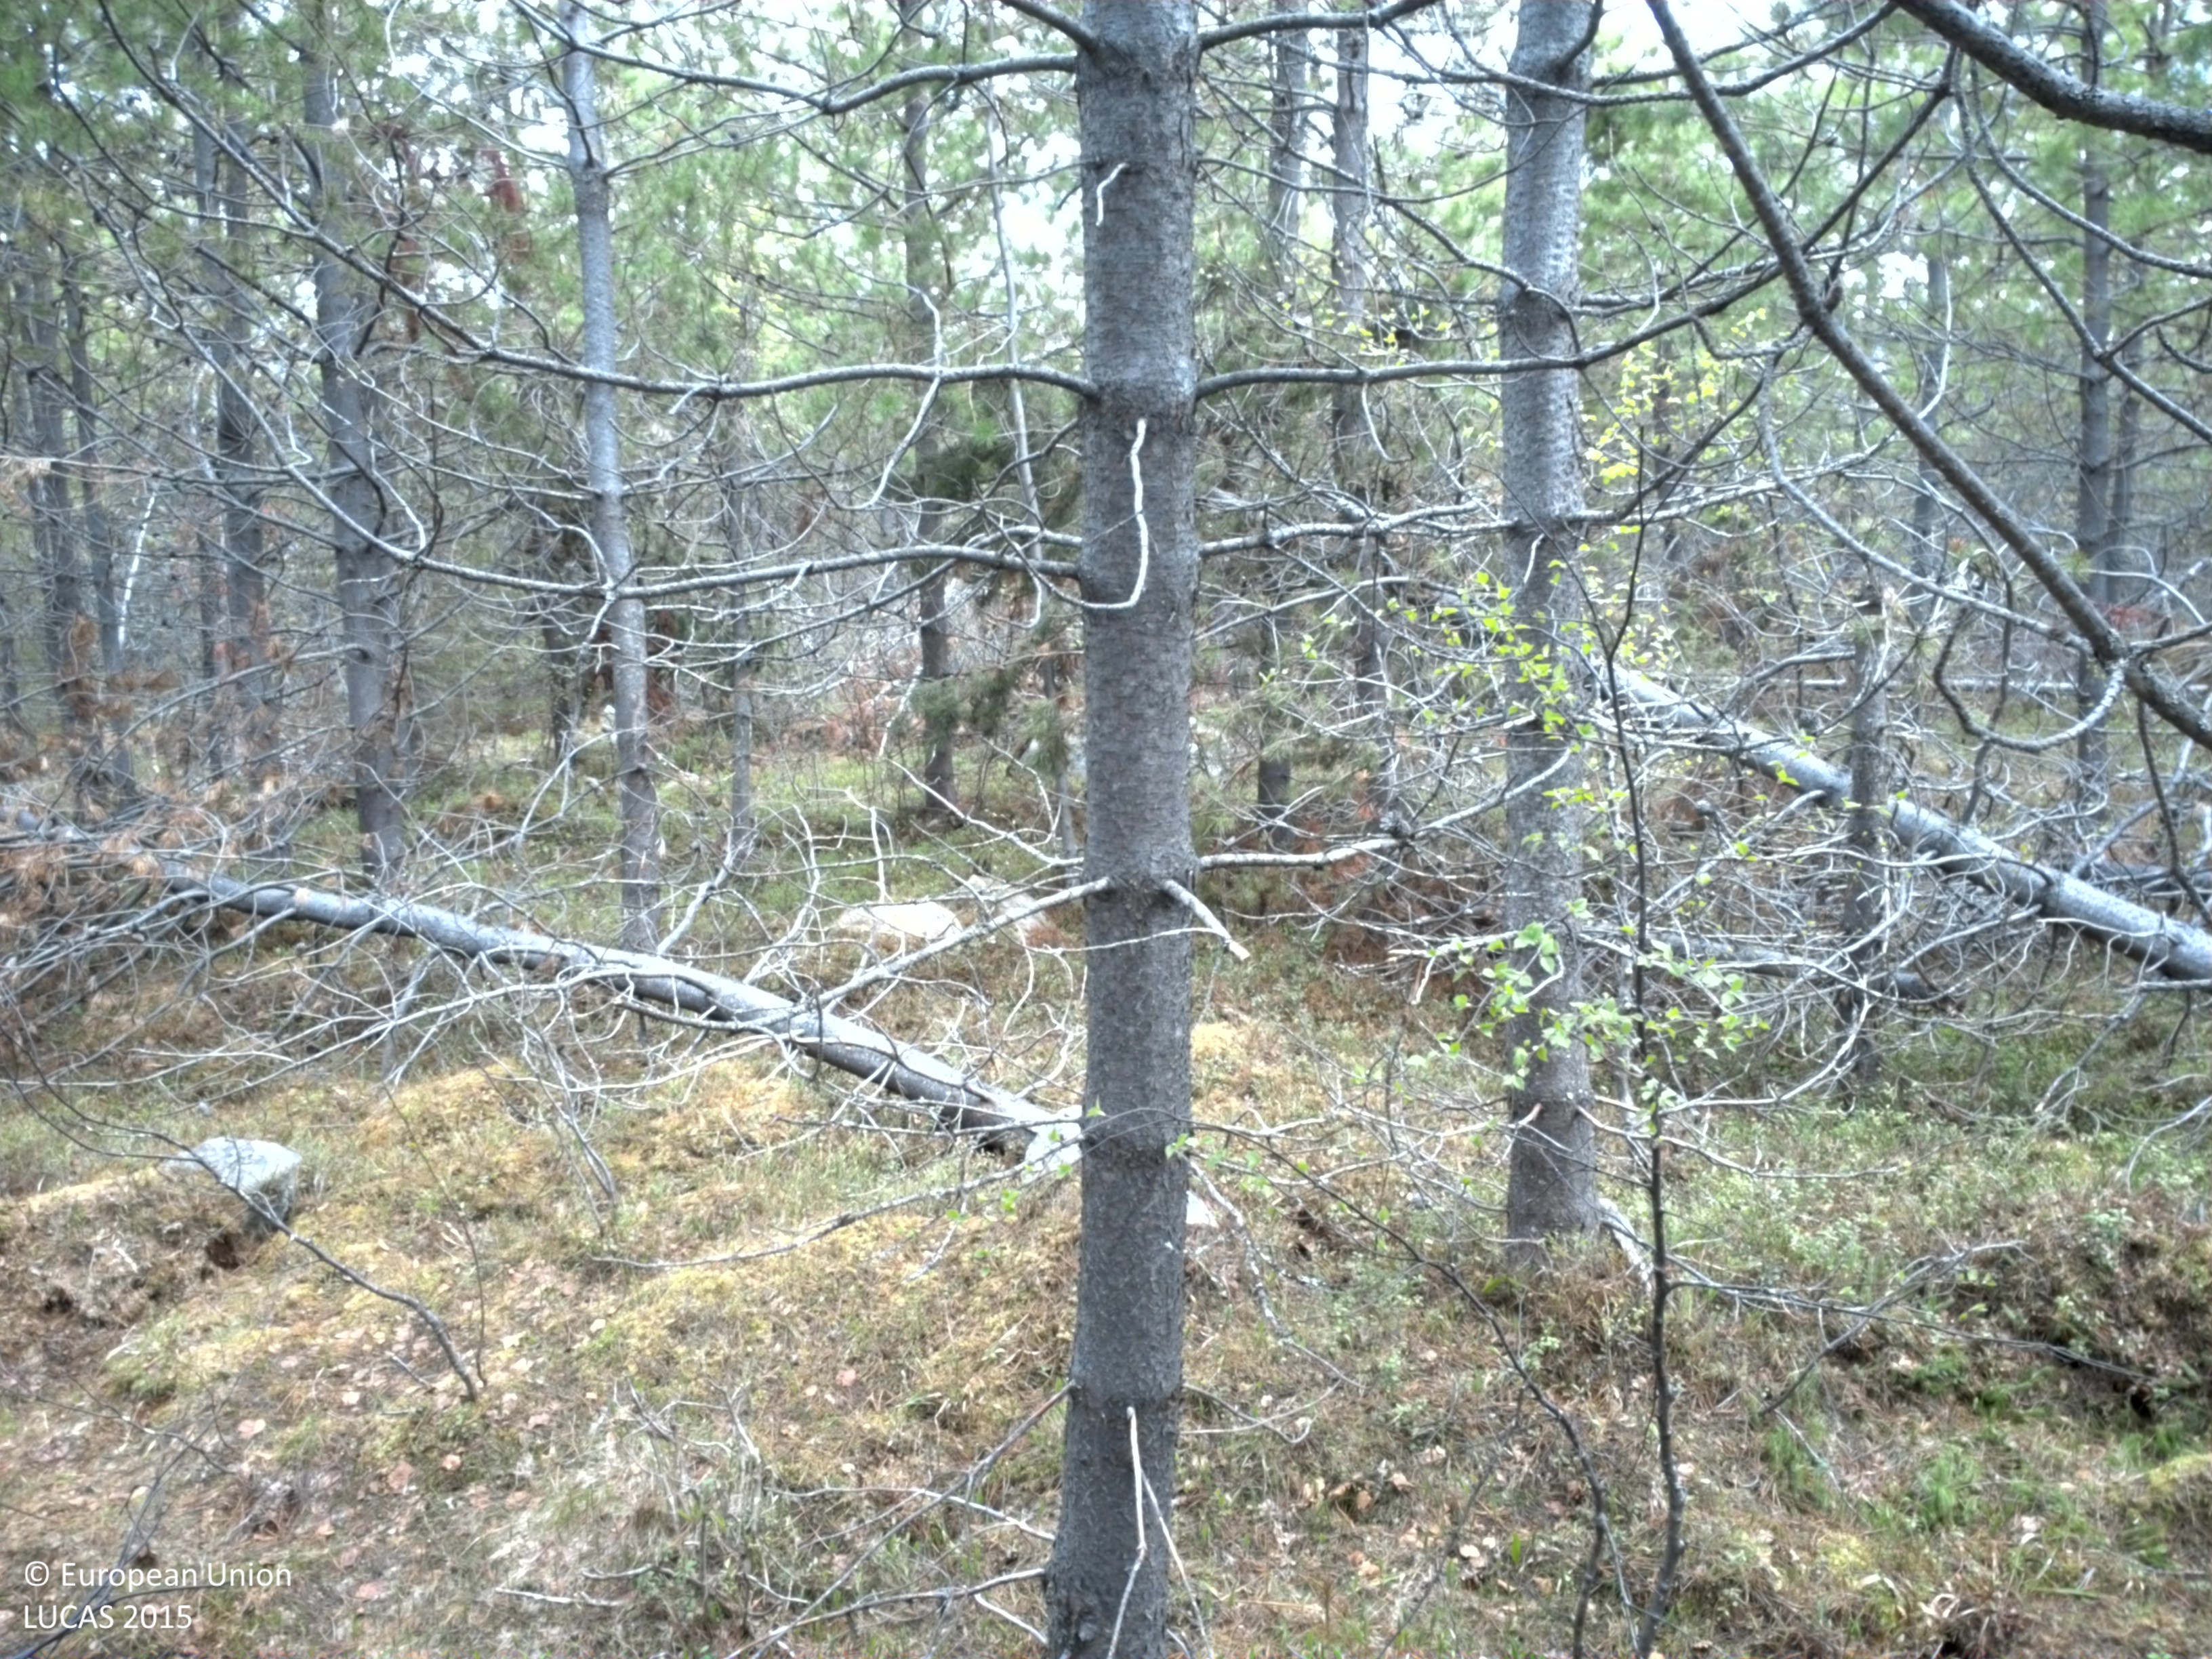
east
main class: Woodland
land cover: Pine dominated coniferous woodland
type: exotic forest
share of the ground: > 75 %
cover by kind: coniferous forest trees 75 %, shrubs 15 %, broadleaved forest trees 5 %, lichens and mosses 5 %
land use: Forestry
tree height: > 5 m
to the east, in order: Pine dominated coniferous woodland; Pine dominated mixed woodland; Broadleaved woodland; Ditches and canals; Broadleaved woodland
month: June
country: SE
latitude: 66.2667
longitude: 22.2856
